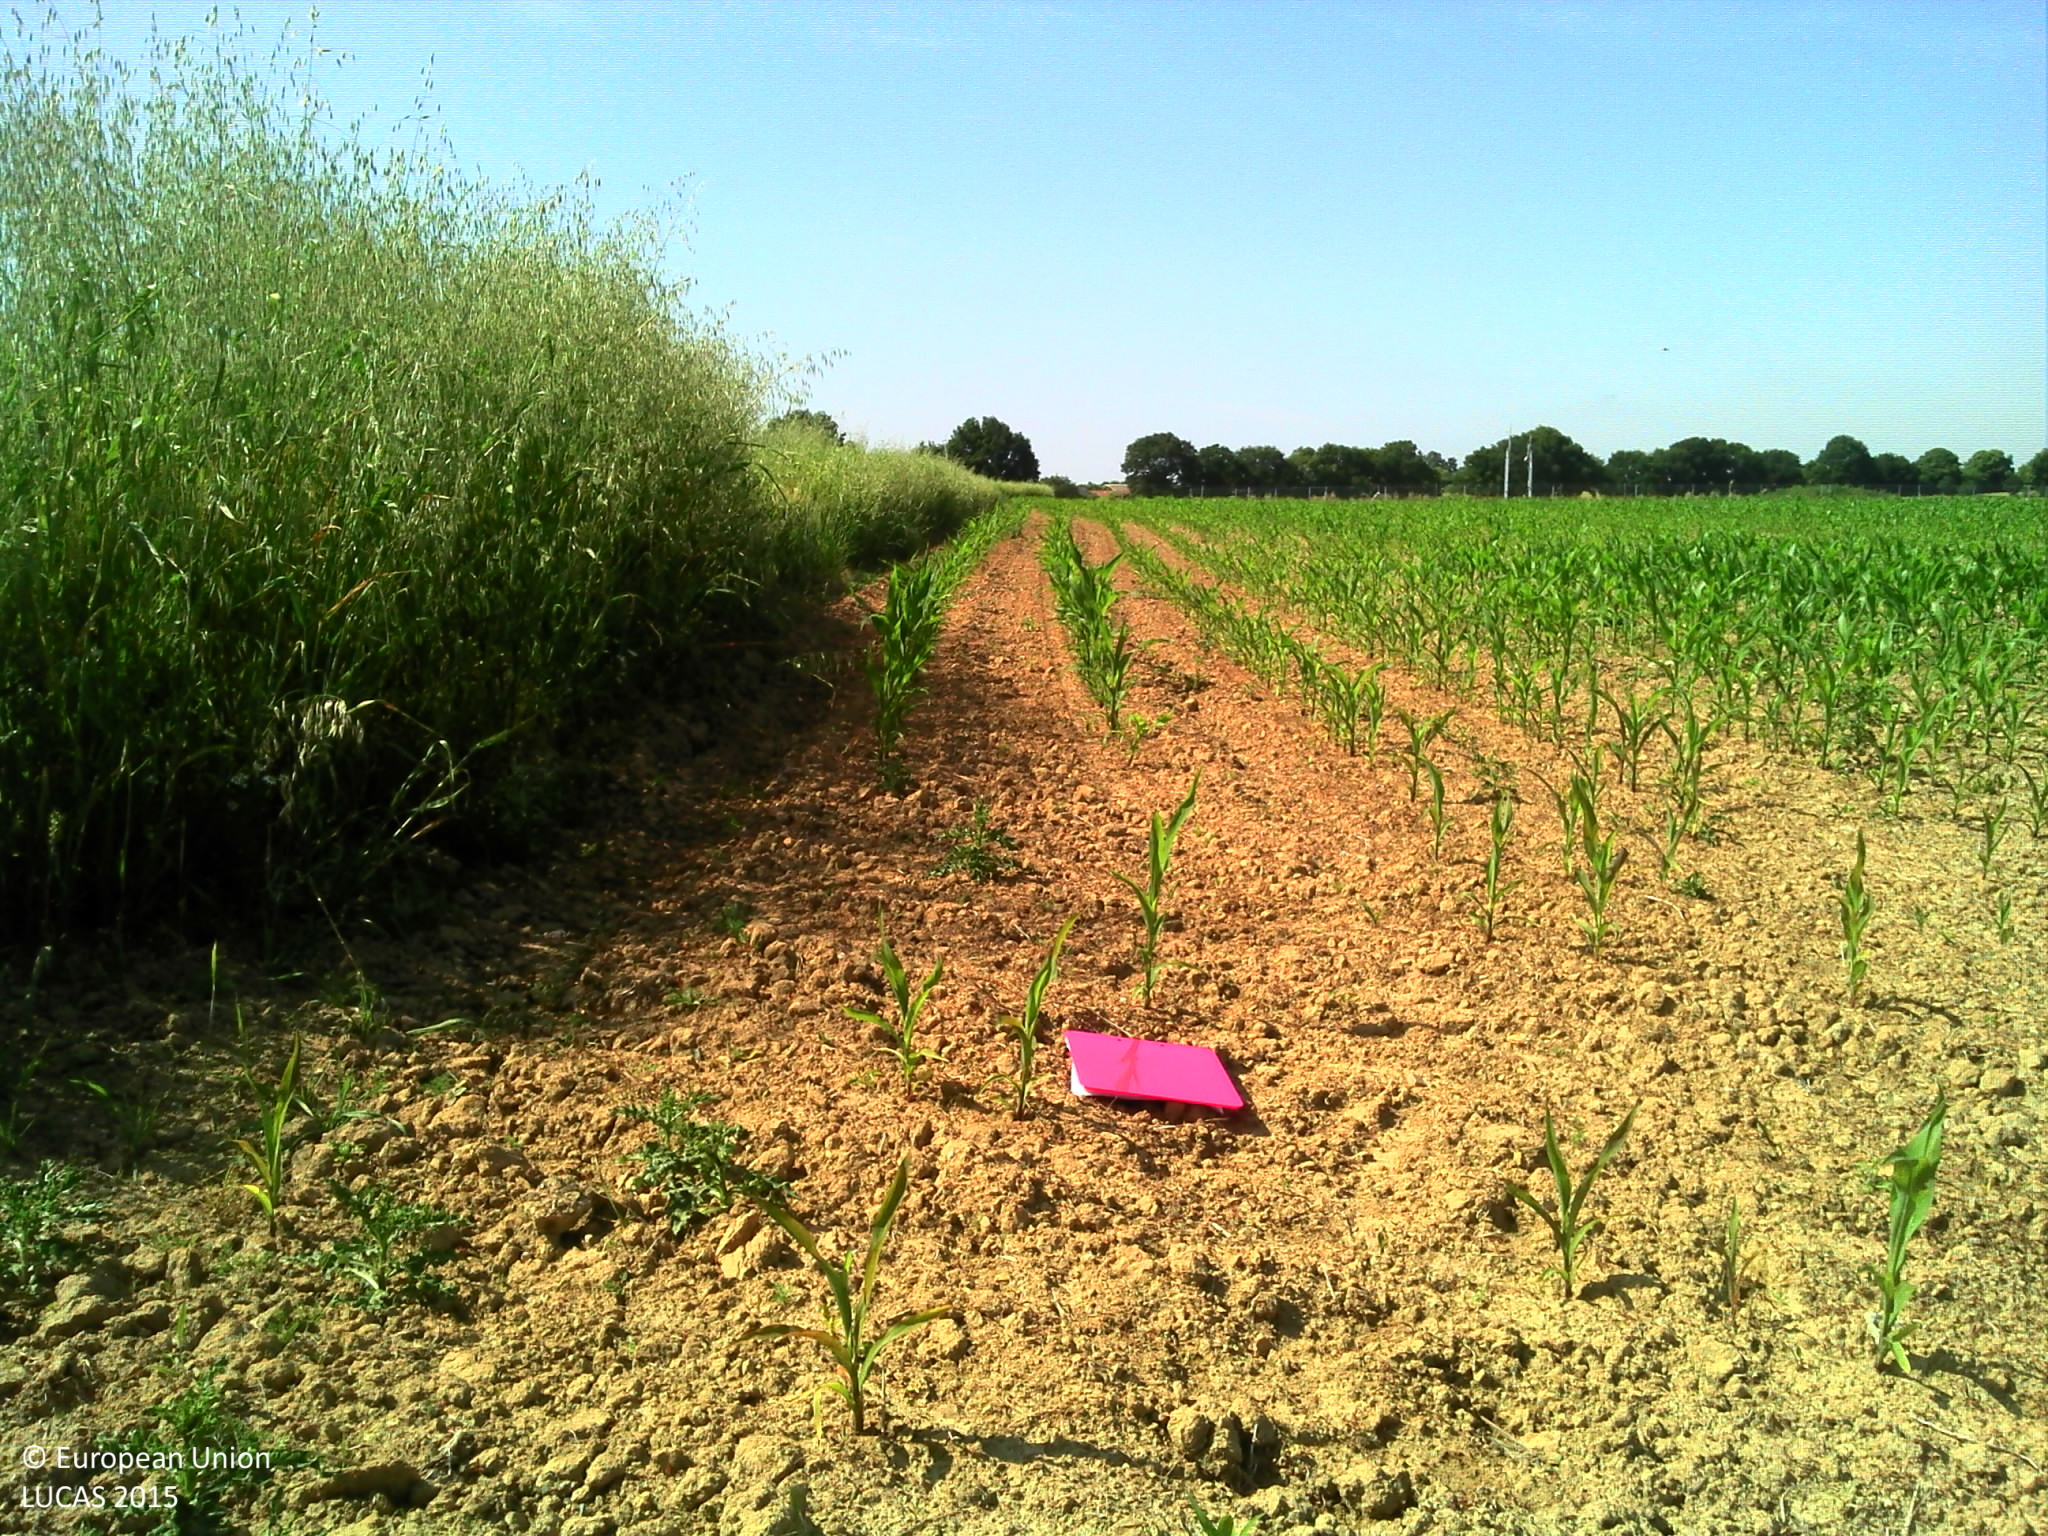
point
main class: Cropland
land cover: Maize
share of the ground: 10 - 25 %
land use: Agriculture (excluding fallow land and kitchen gardens)
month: June
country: FR
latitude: 48.0623
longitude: -1.4370
